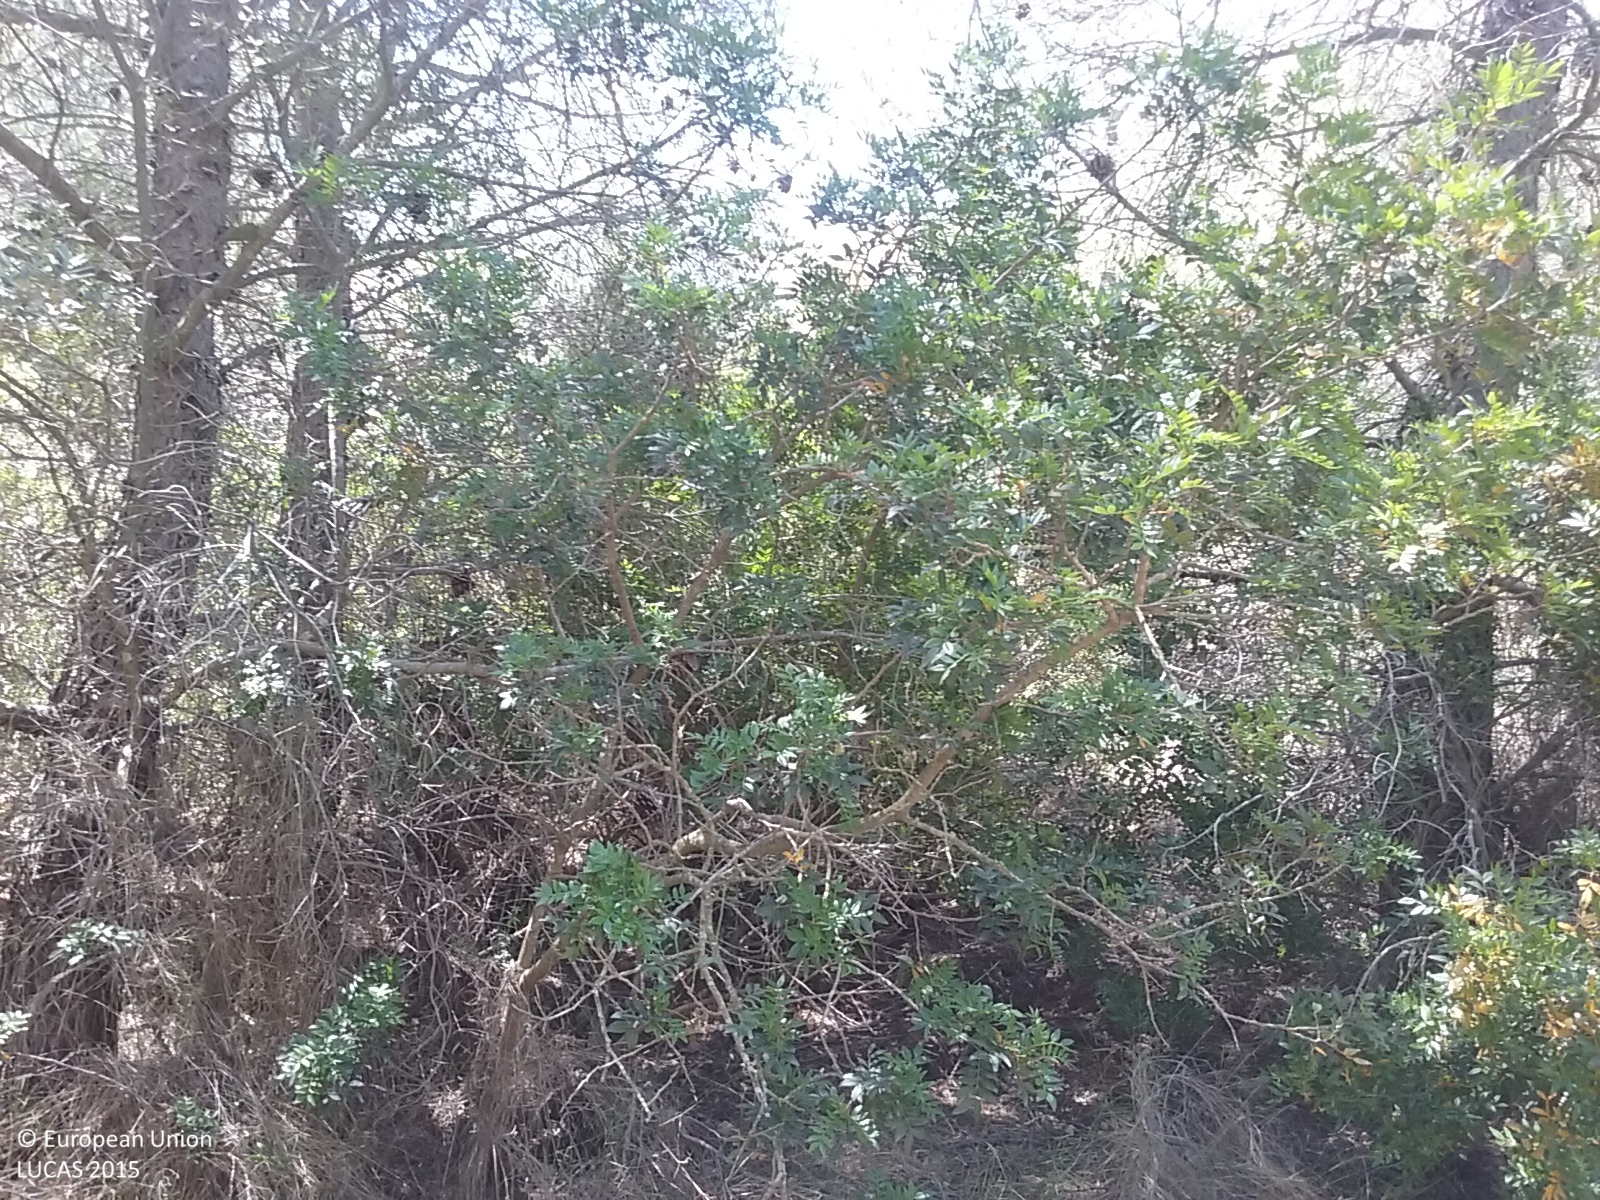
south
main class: Woodland
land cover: Pine dominated coniferous woodland
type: coniferous forest of the mediterranean region
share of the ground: 50 - 75 %
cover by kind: coniferous forest trees 50 %, shrubs 50 %
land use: Forestry
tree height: > 5 m
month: May
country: ES
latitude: 40.2993
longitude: 0.3387
